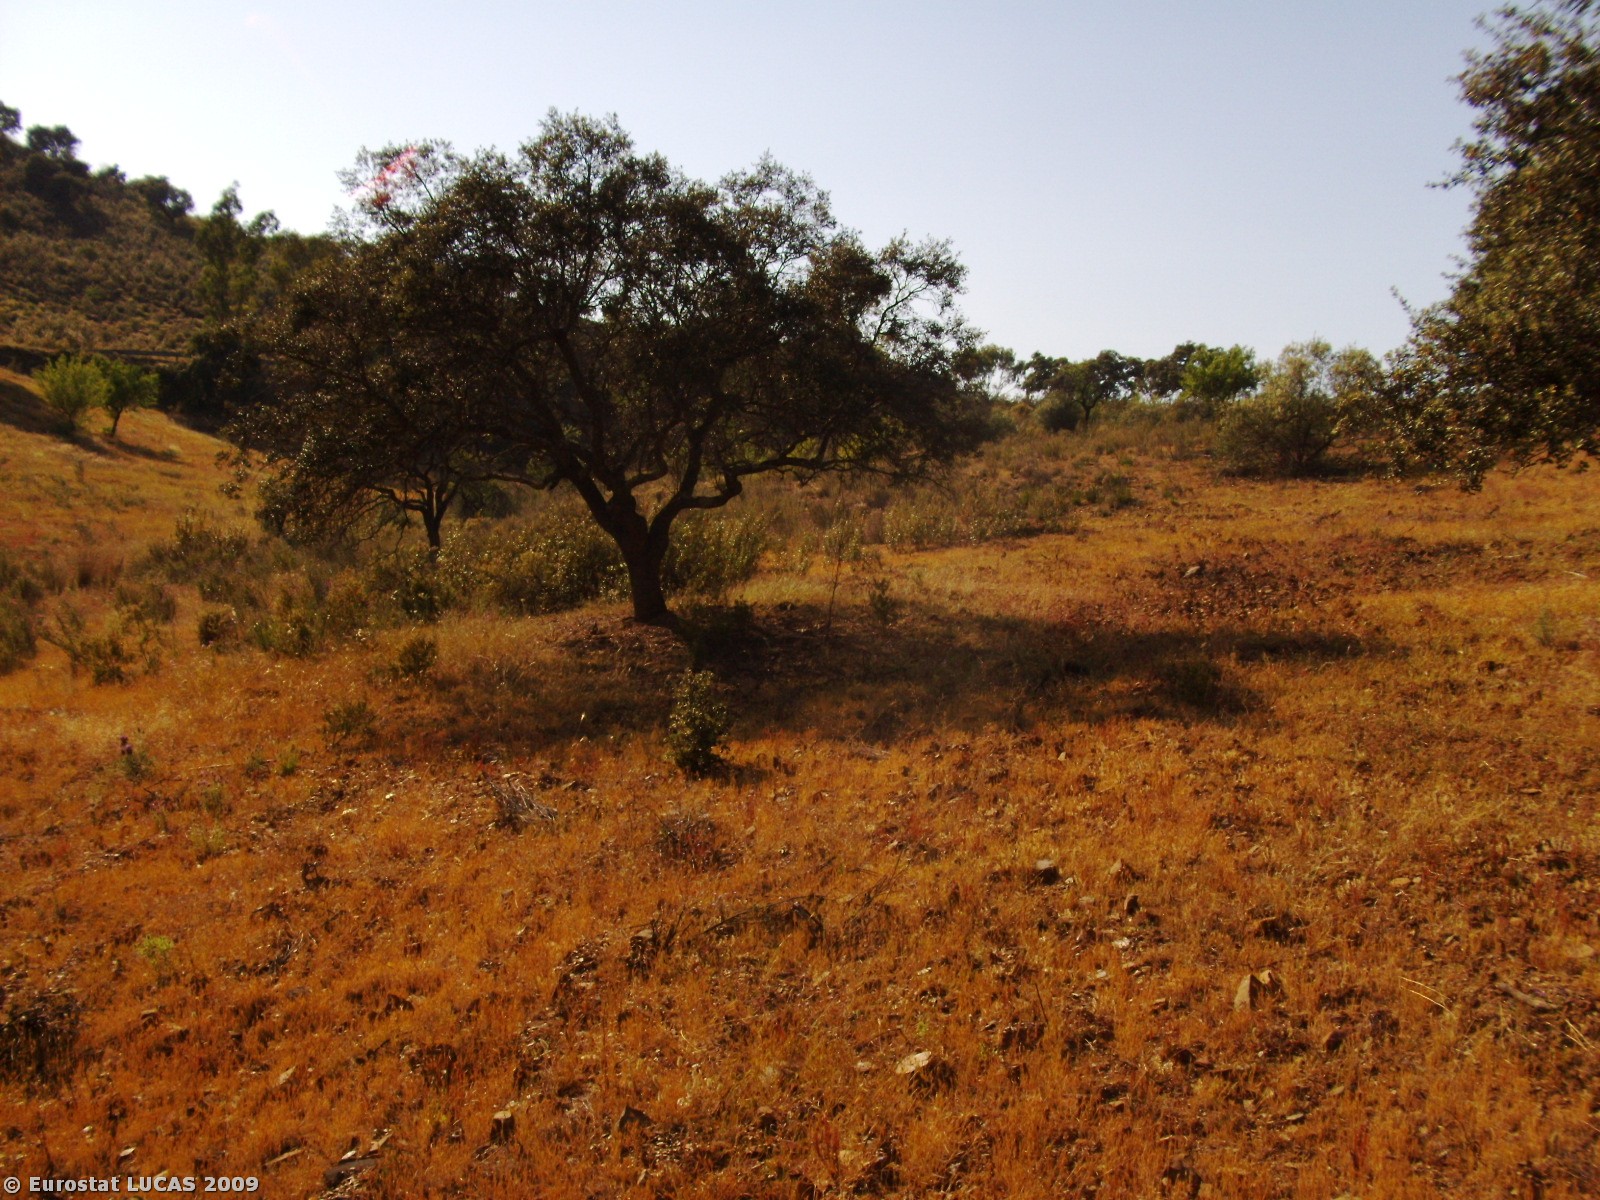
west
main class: Grassland
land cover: Grassland with sparse tree/shrub cover
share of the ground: 25 - 50 %
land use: Forestry
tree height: > 5 m
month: May
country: PT
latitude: 37.3827
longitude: -7.5242
